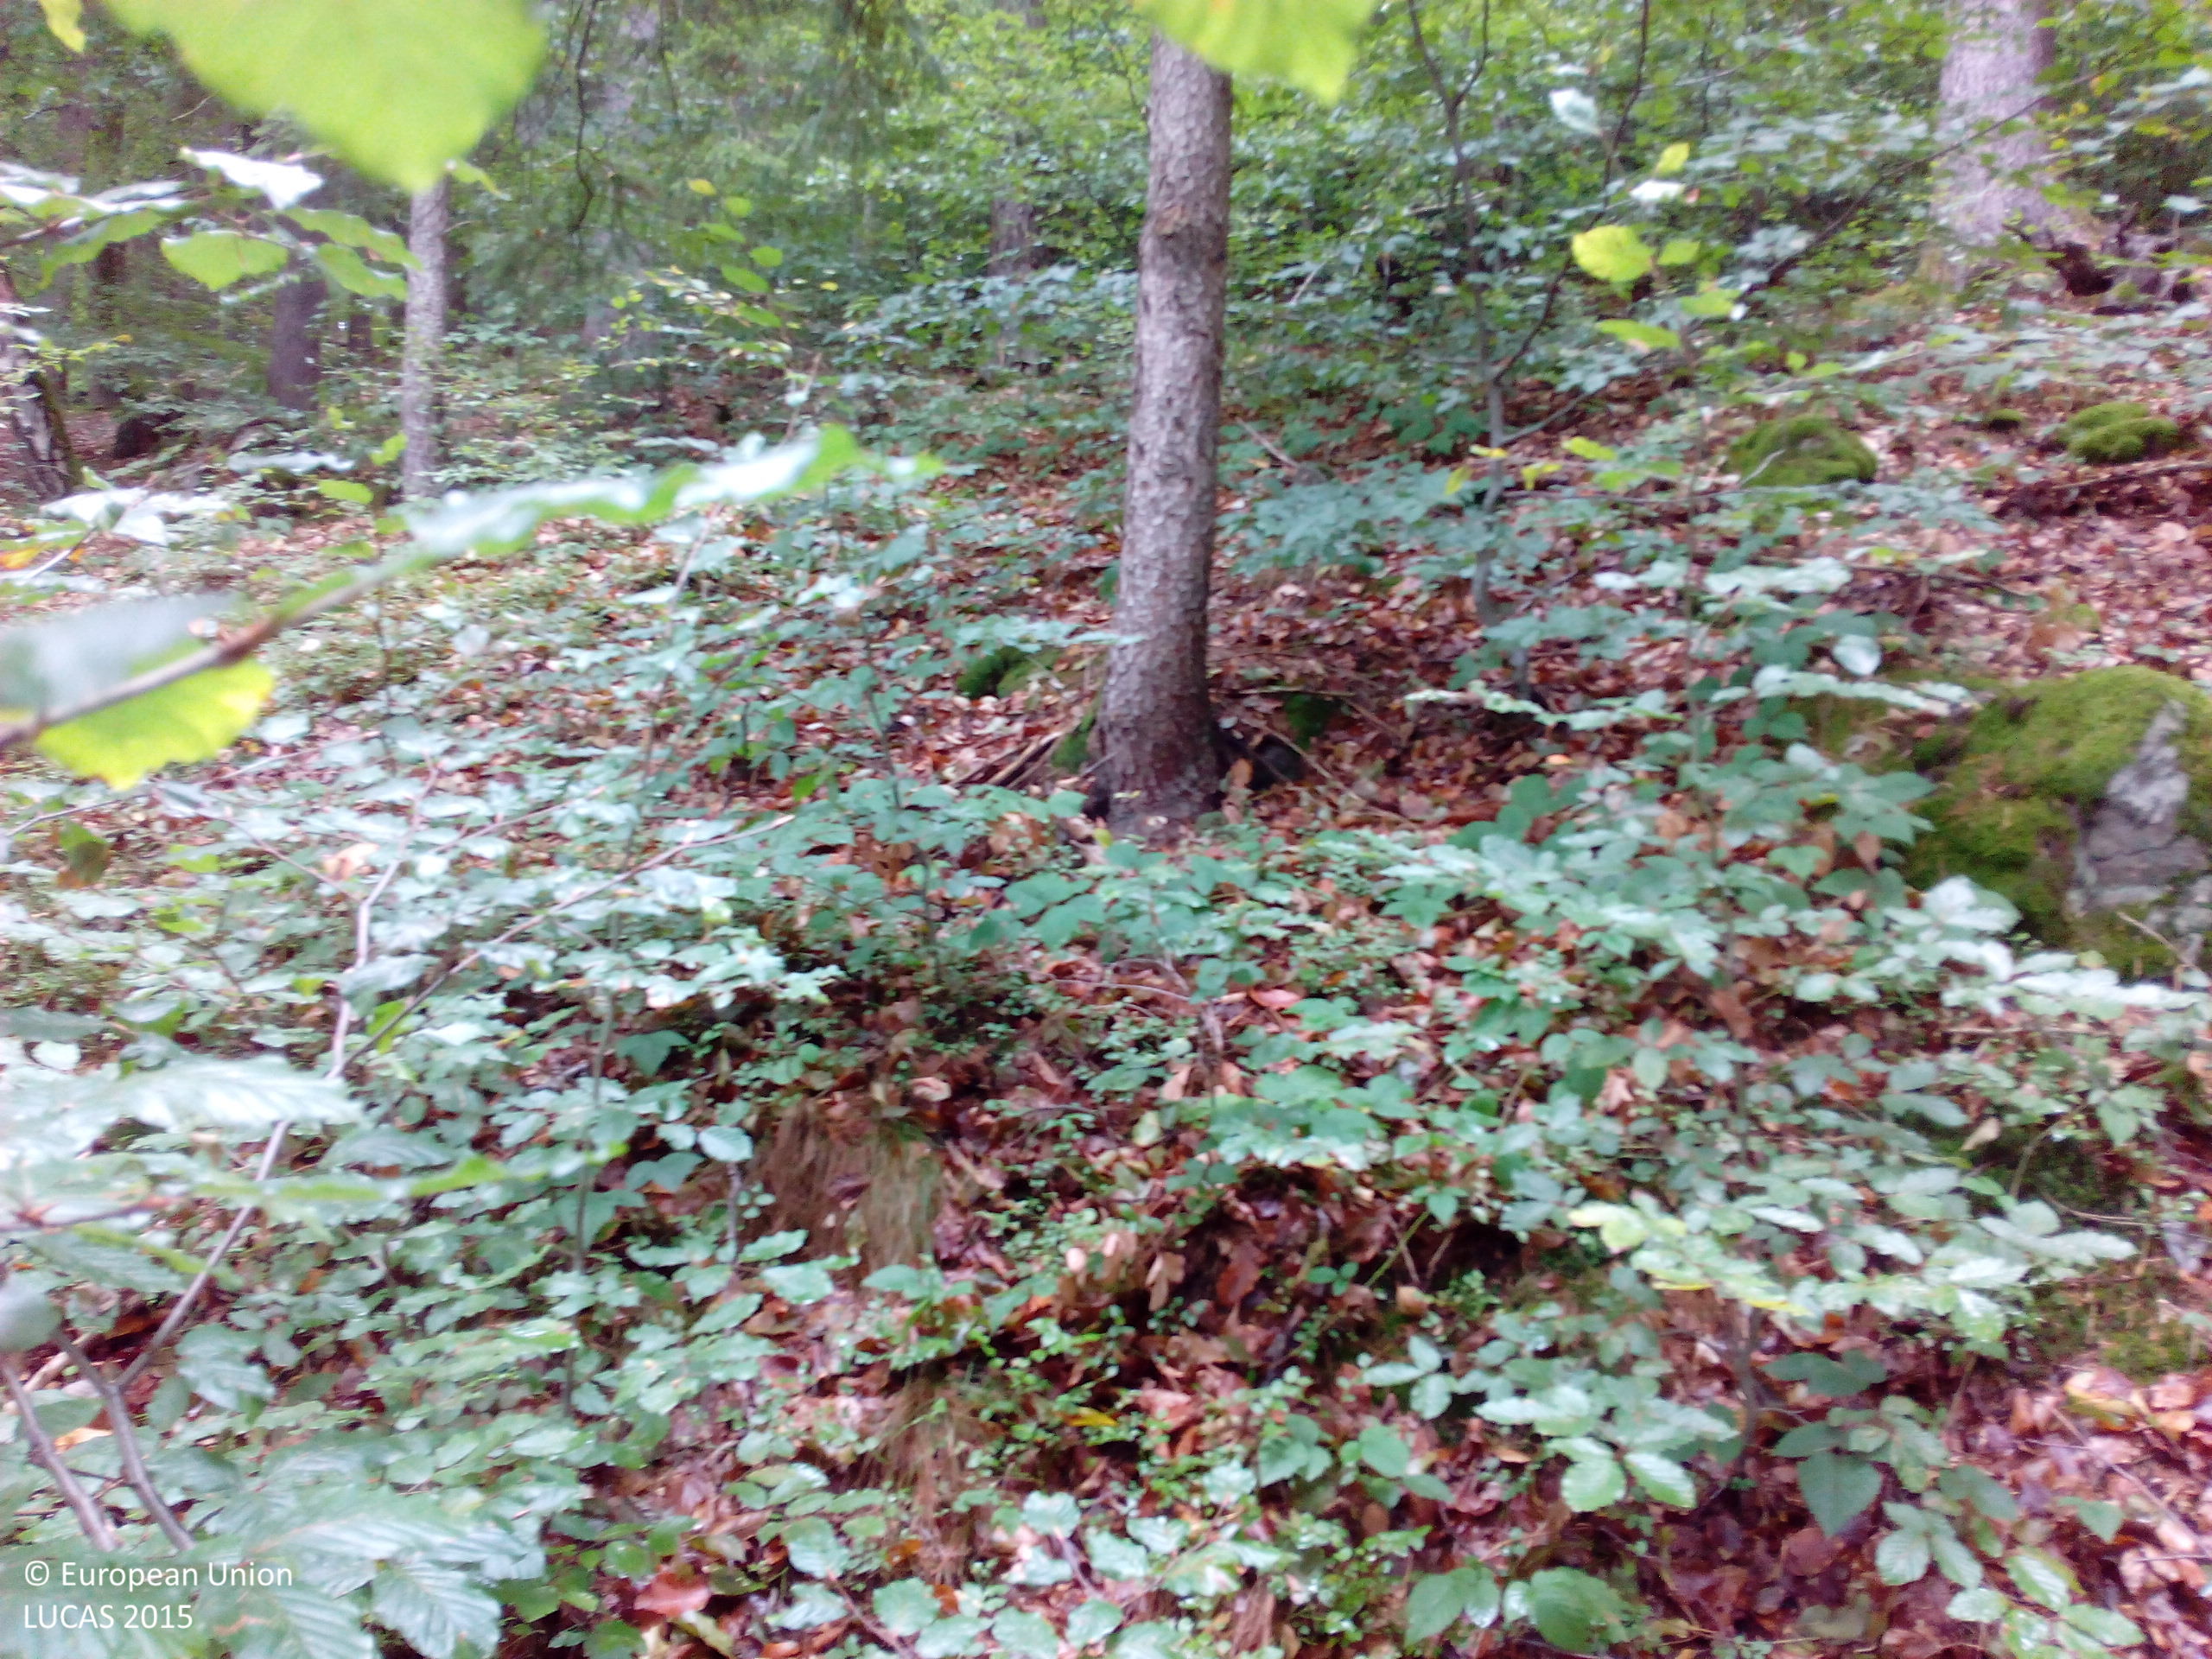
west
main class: Woodland
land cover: Spruce dominated mixed woodland
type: hemiboreal forest and nemoral coniferous forest and mixed broadleaved-coniferous forest
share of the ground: 50 - 75 %
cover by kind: unconsolidated bare surface 45 %, coniferous forest trees 30 %, broadleaved forest trees 25 %
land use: Forestry
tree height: > 5 m
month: September
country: DE
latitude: 48.9112
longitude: 13.3427
